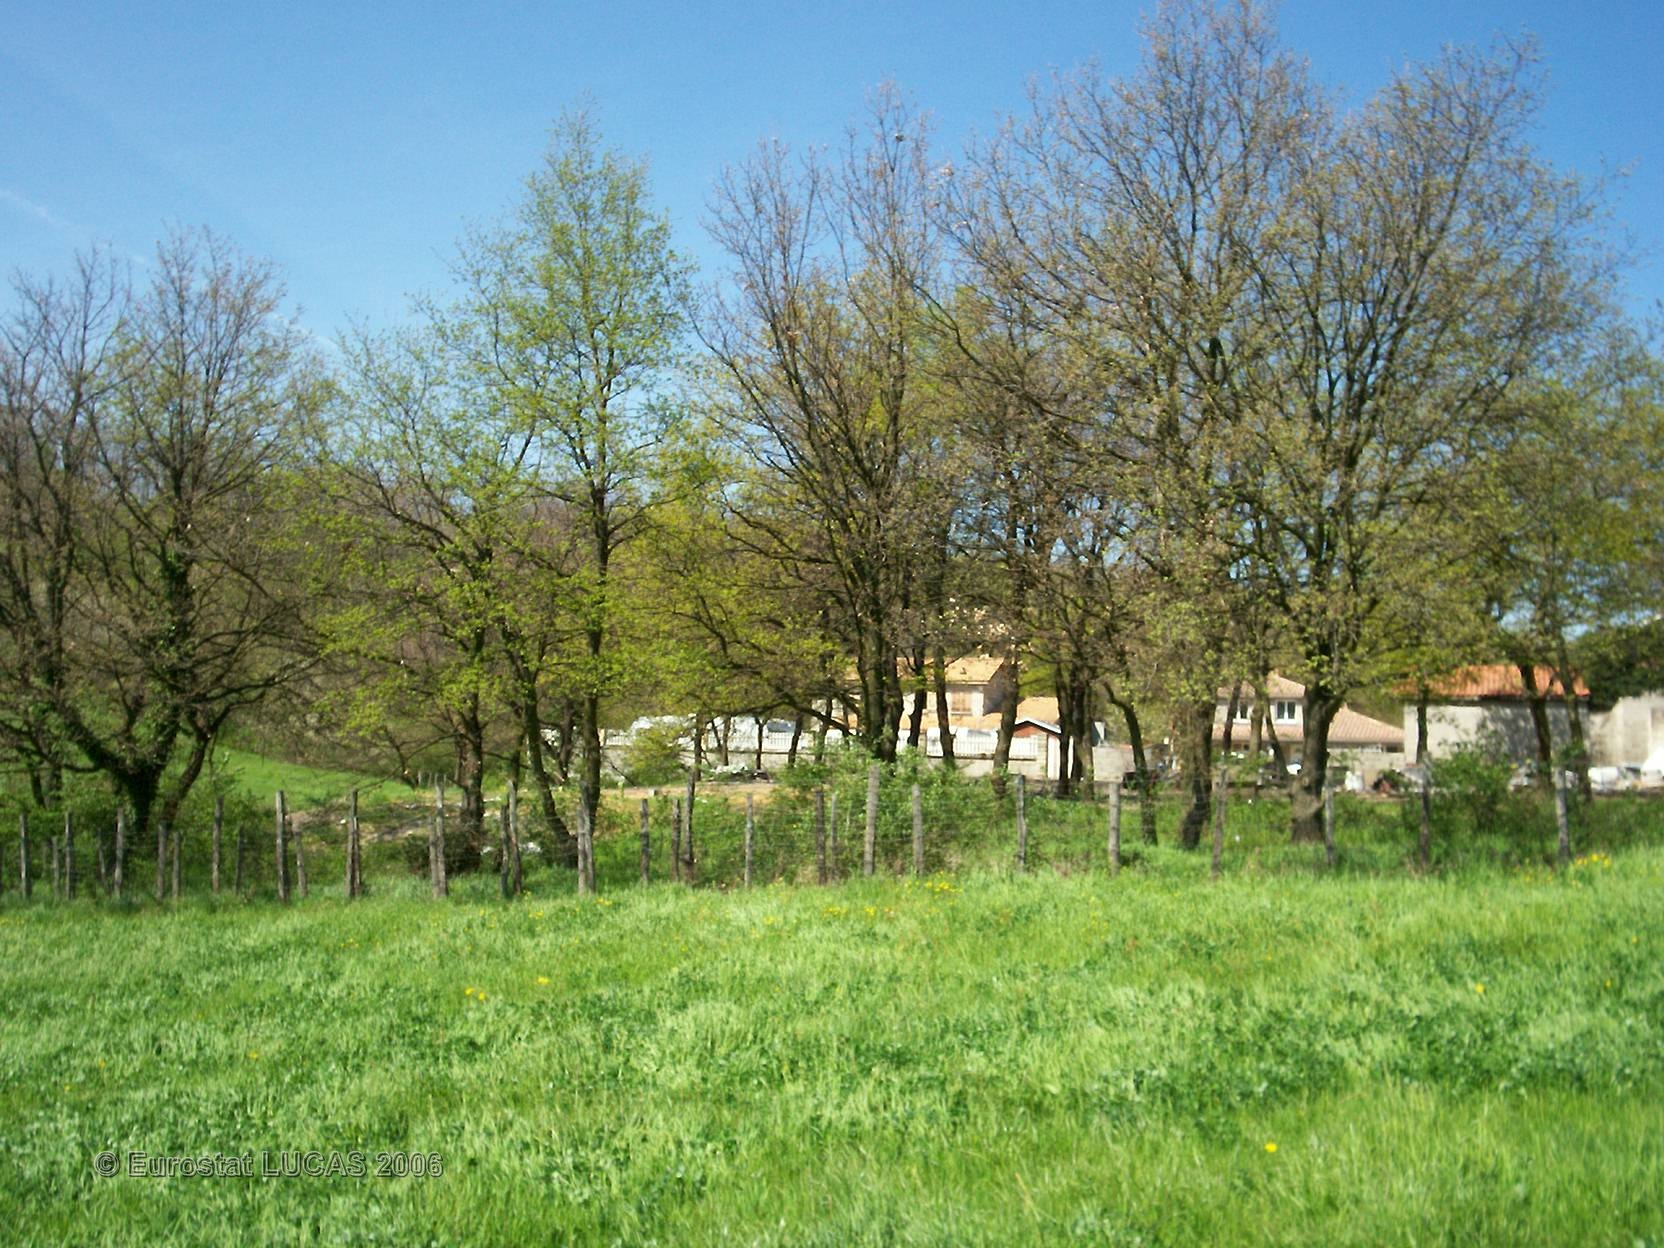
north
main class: Grassland
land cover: Grassland without tree/shrub cover
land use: Agriculture (excluding fallow land and kitchen gardens)
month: April
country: FR
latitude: 45.5936
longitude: 4.8123
